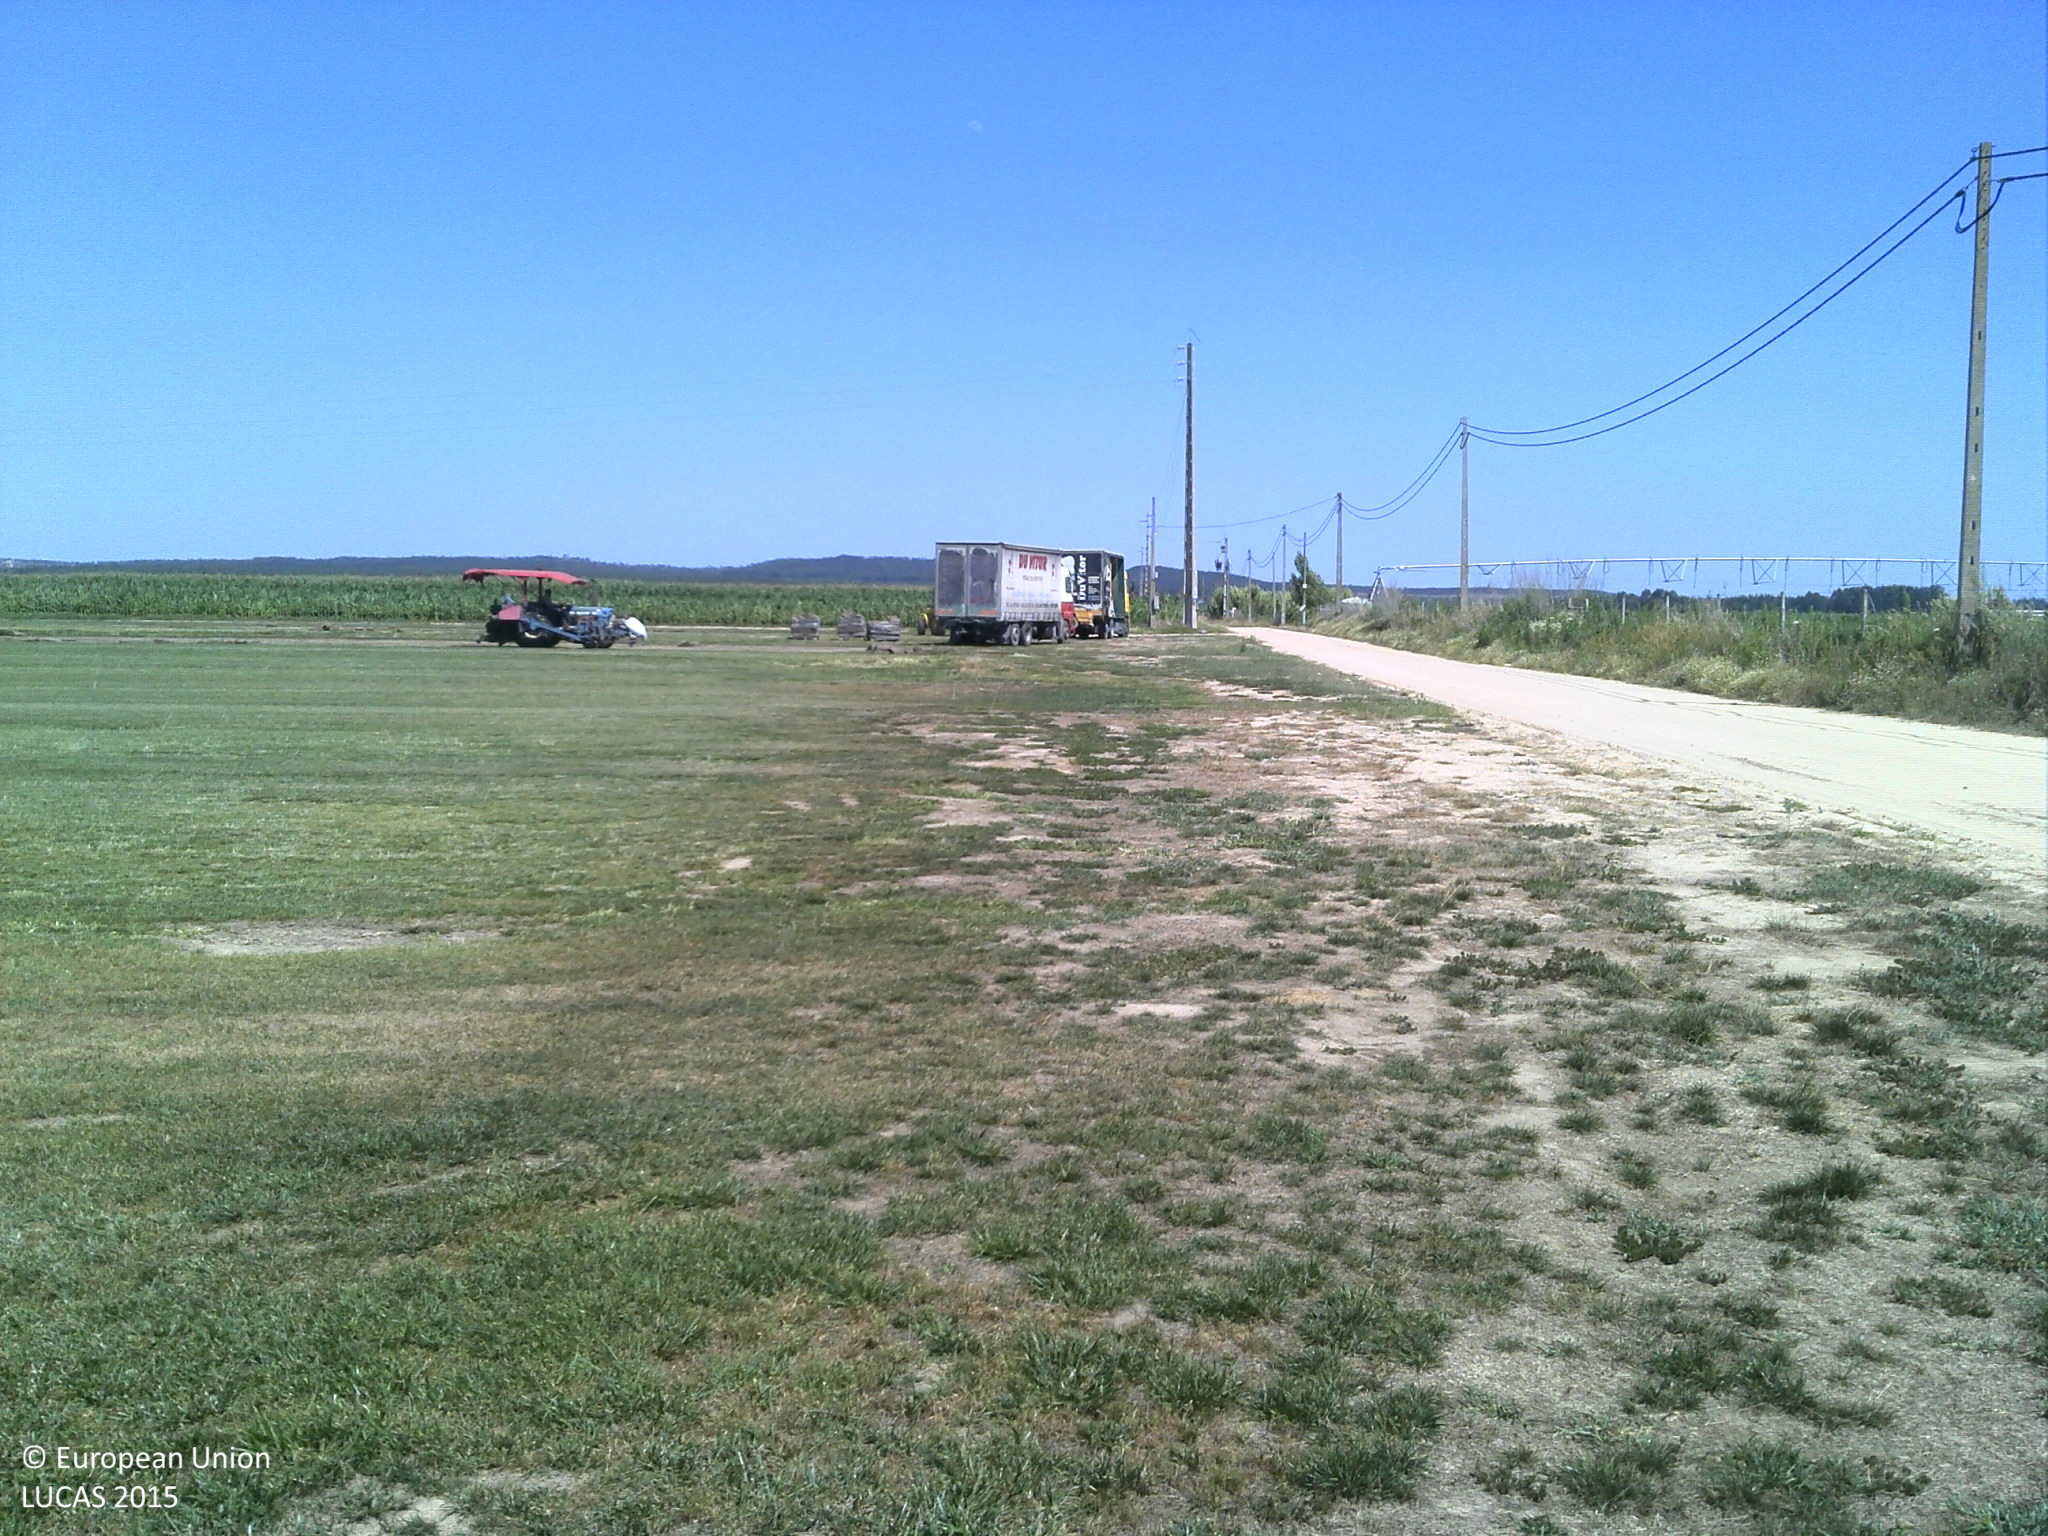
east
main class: Cropland
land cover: Nurseries
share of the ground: > 75 %
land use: Agriculture (excluding fallow land and kitchen gardens)
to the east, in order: Nurseries; Grass margins; Tracks; Electric lines; Maize
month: June
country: PT
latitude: 39.1478
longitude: -8.6408
